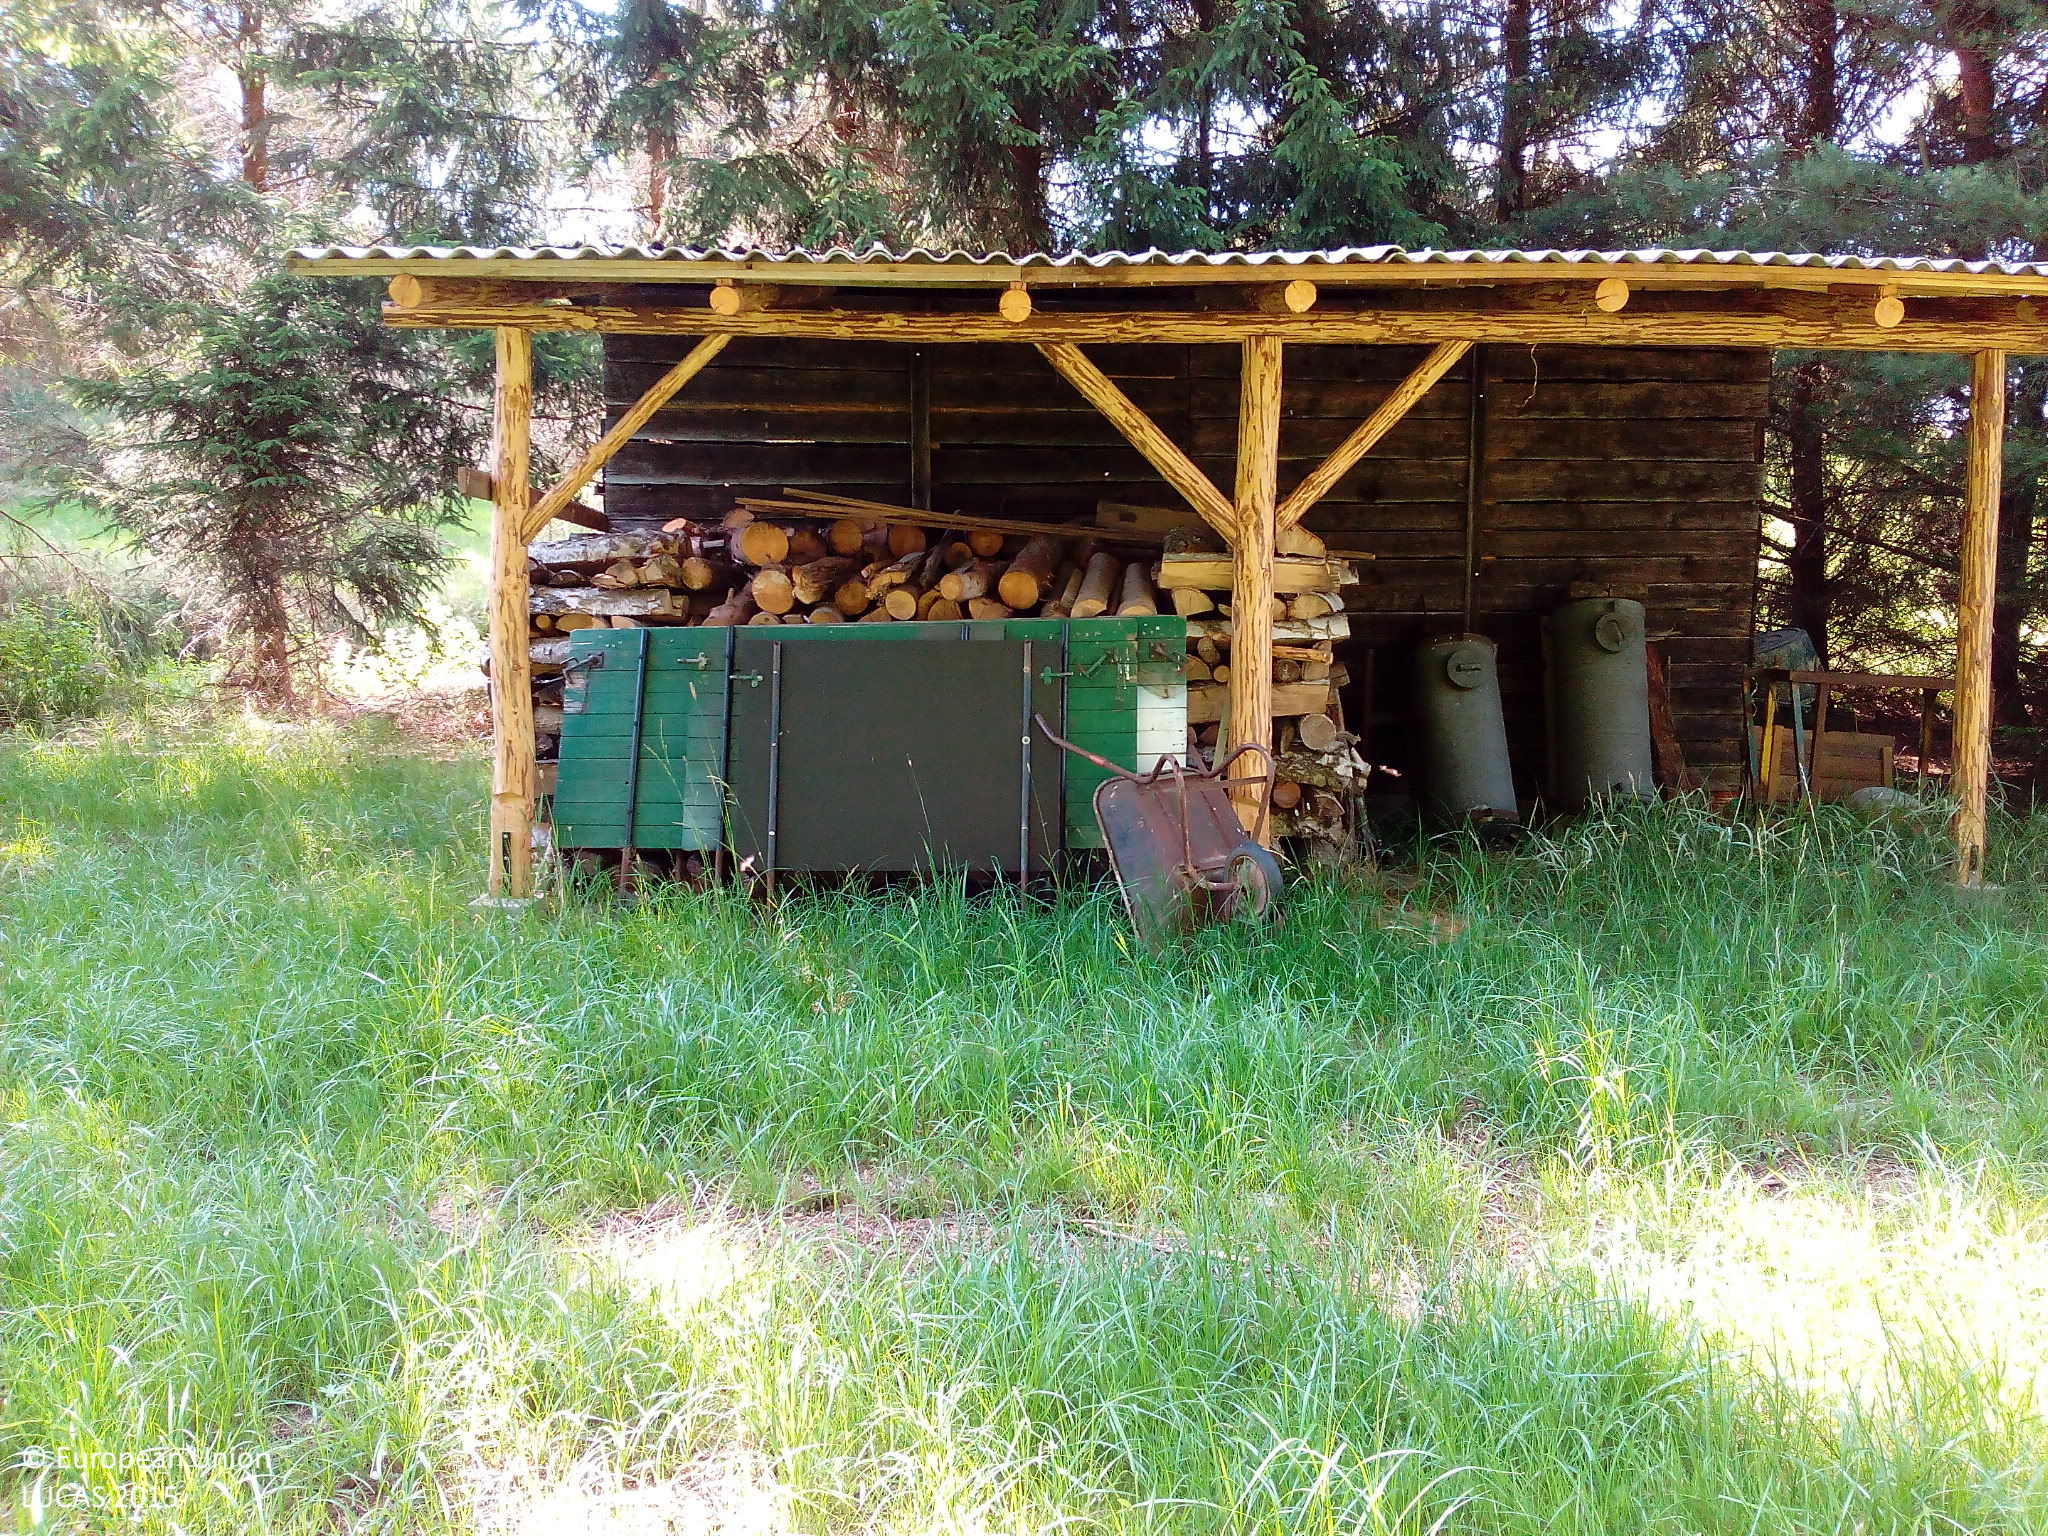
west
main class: Grassland
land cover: Grassland without tree/shrub cover
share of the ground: > 75 %
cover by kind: herbaceous plants 100 %
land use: Agriculture (excluding fallow land and kitchen gardens)
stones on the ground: < 10 %
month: July
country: DE
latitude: 50.9393
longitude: 9.8720
